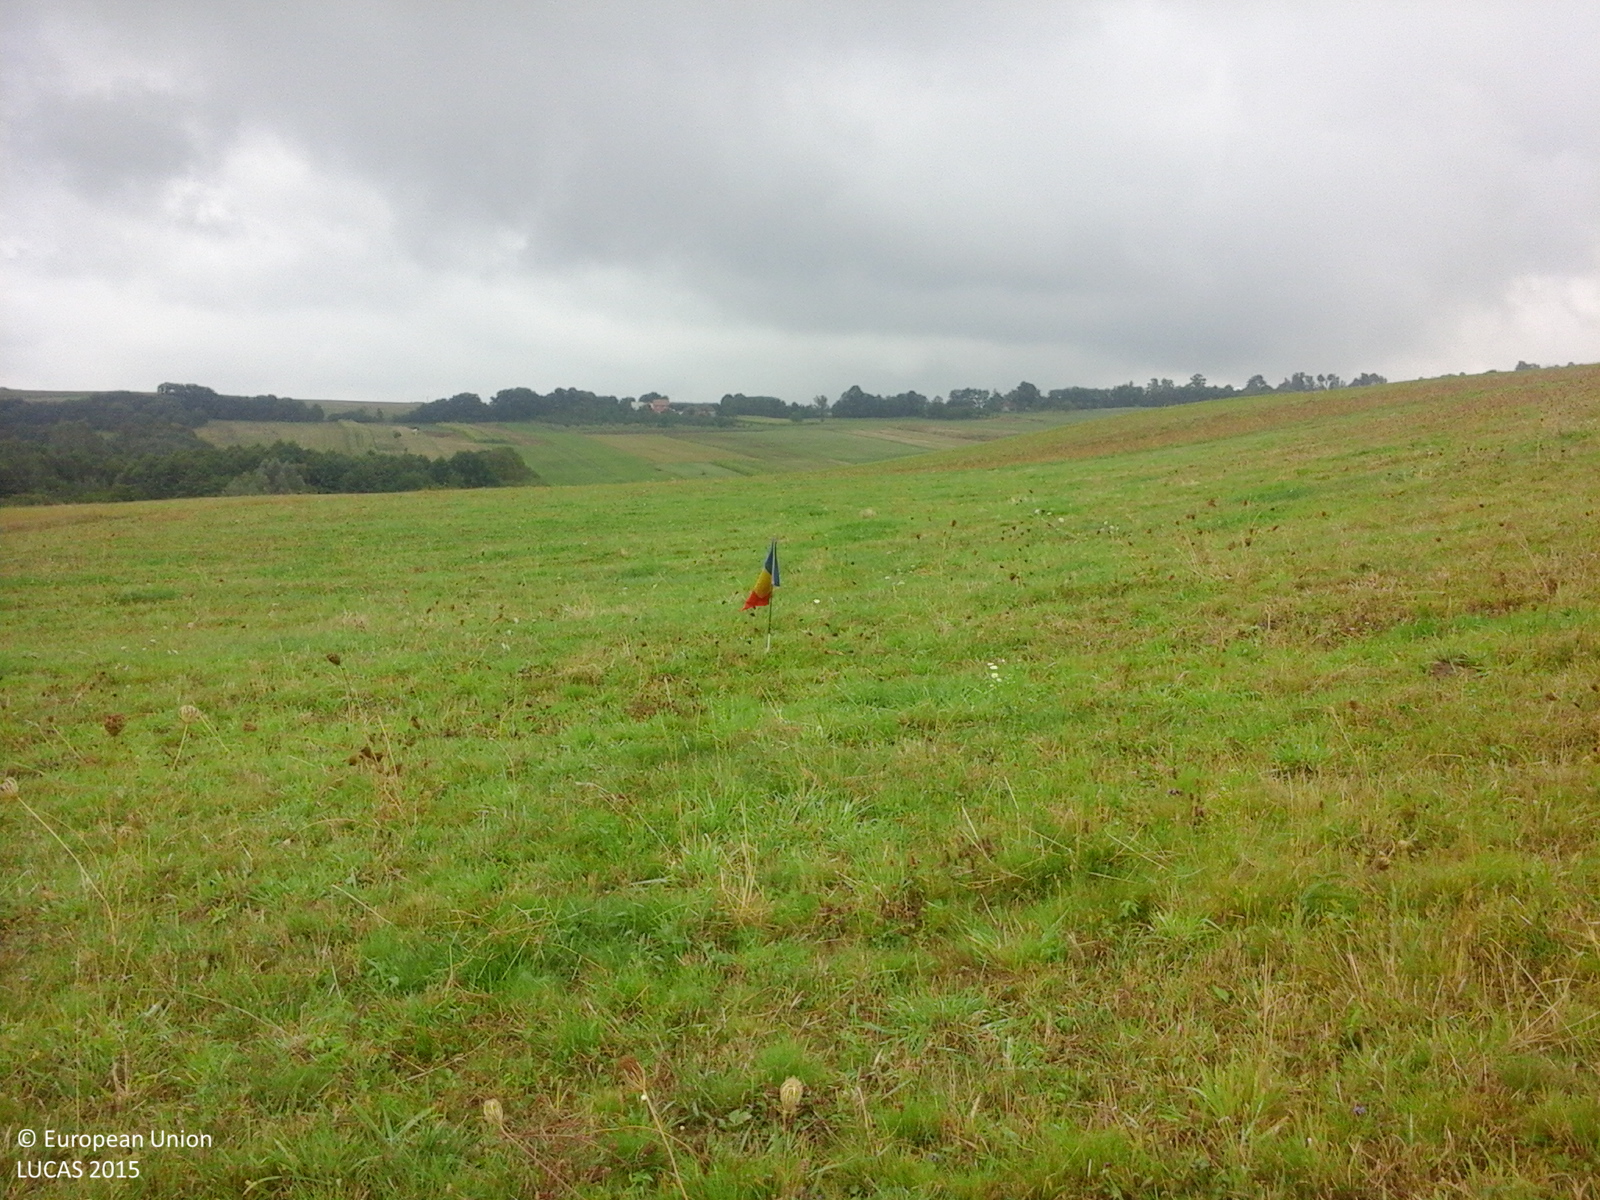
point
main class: Grassland
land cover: Grassland without tree/shrub cover
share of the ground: > 75 %
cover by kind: herbaceous plants 100 %
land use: Agriculture (excluding fallow land and kitchen gardens)
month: September
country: RO
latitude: 46.9712
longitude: 22.5817
